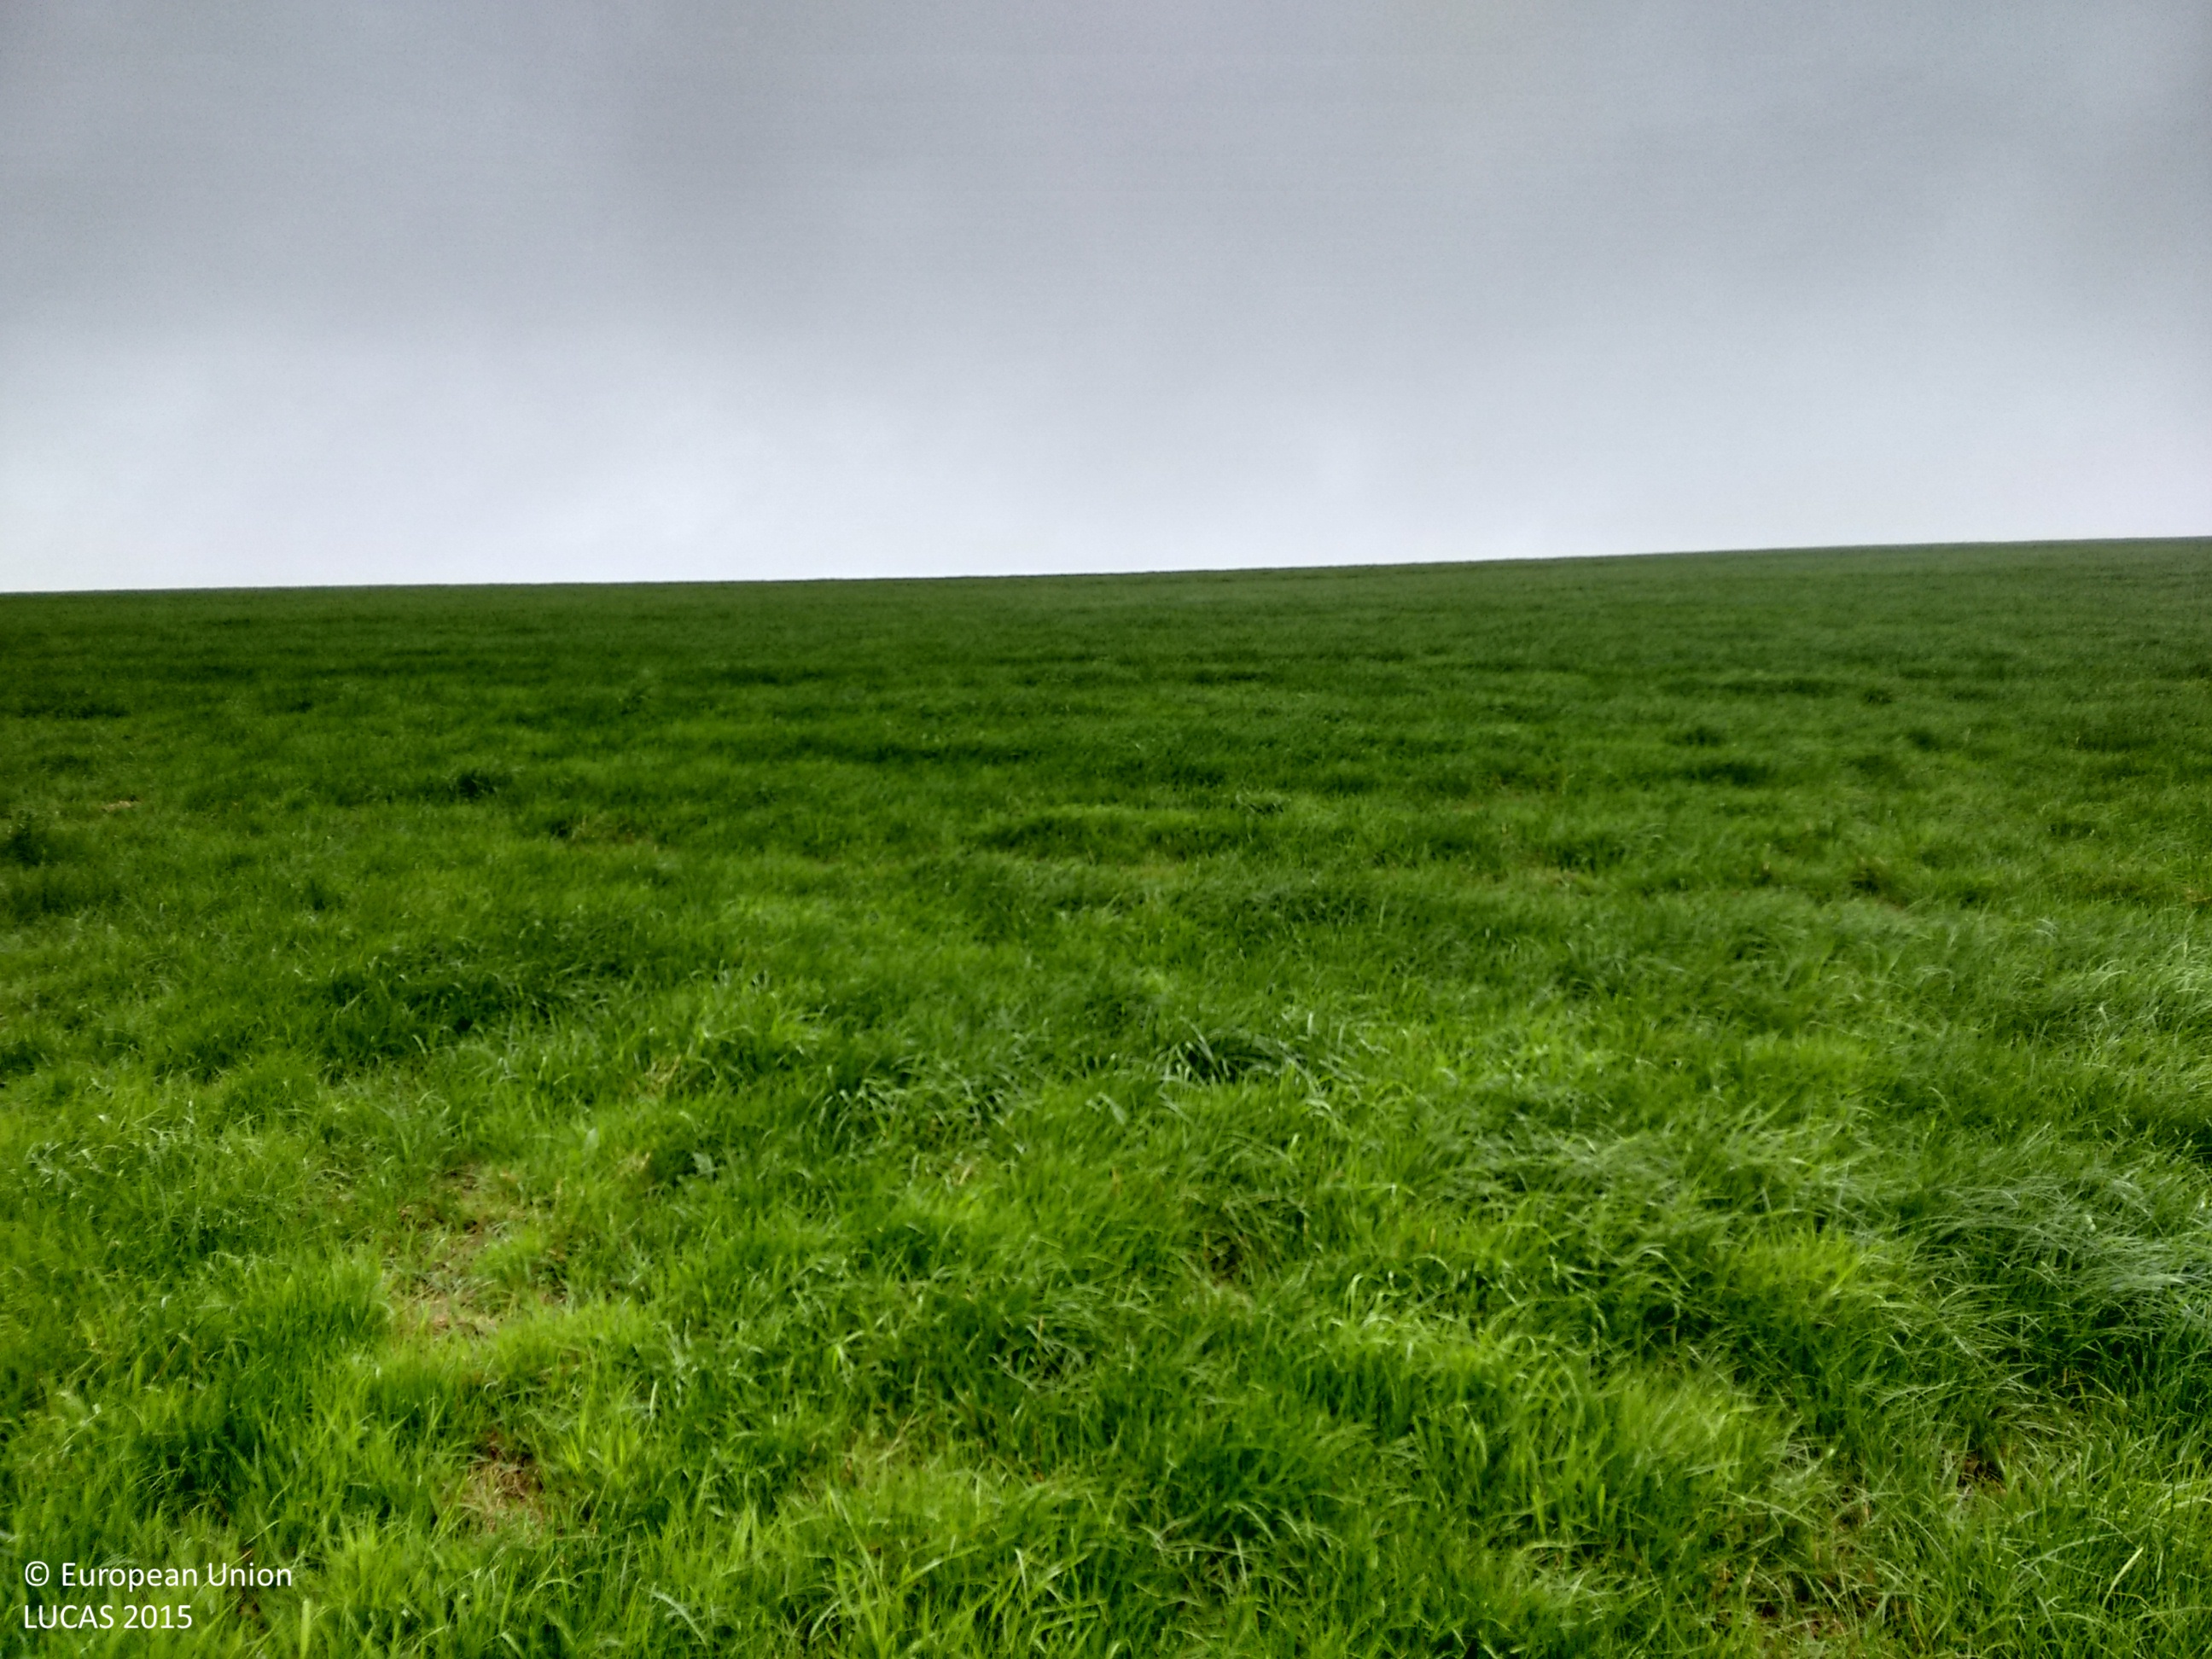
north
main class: Cropland
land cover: Temporary grasslands
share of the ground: > 75 %
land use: Agriculture (excluding fallow land and kitchen gardens)
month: August
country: GB
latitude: 51.8580
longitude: -4.4054
